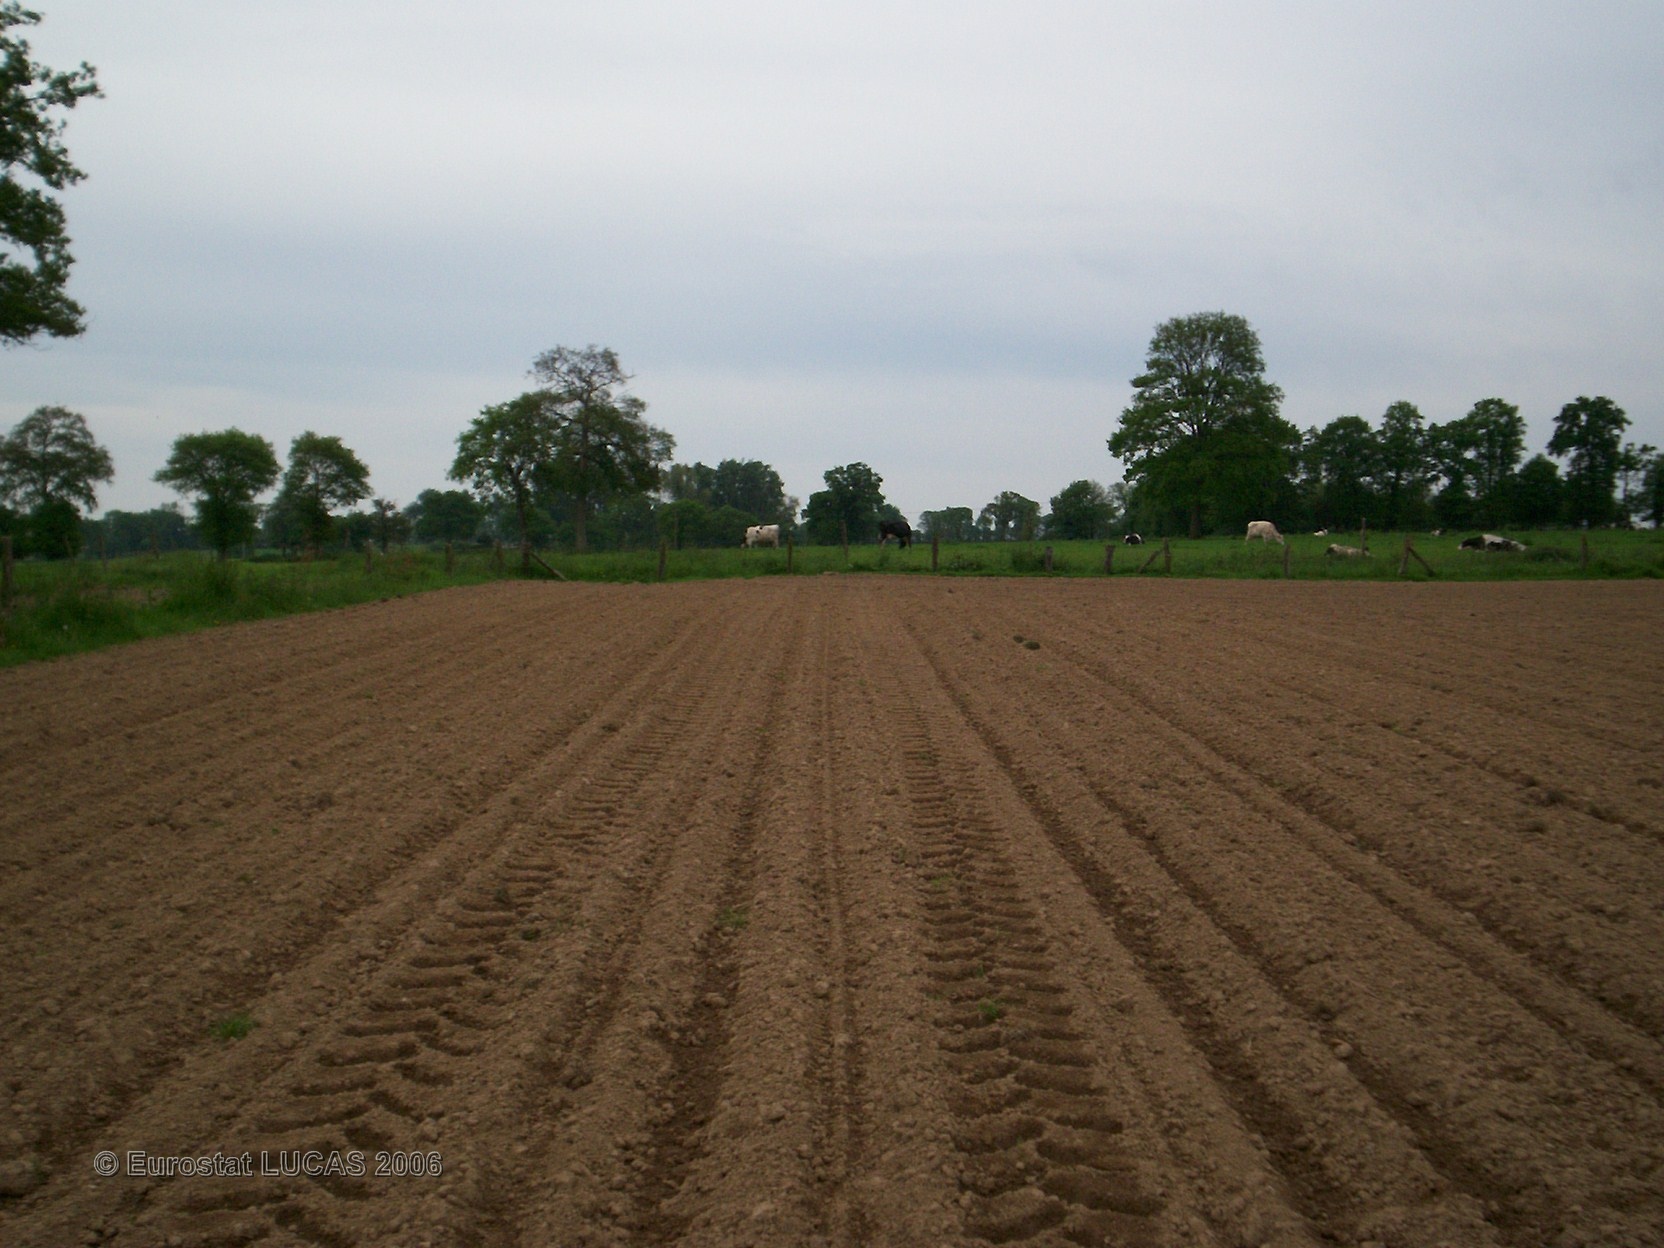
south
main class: Cropland
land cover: Maize
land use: Agriculture (excluding fallow land and kitchen gardens)
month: May
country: FR
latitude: 48.2584
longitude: -1.6457
